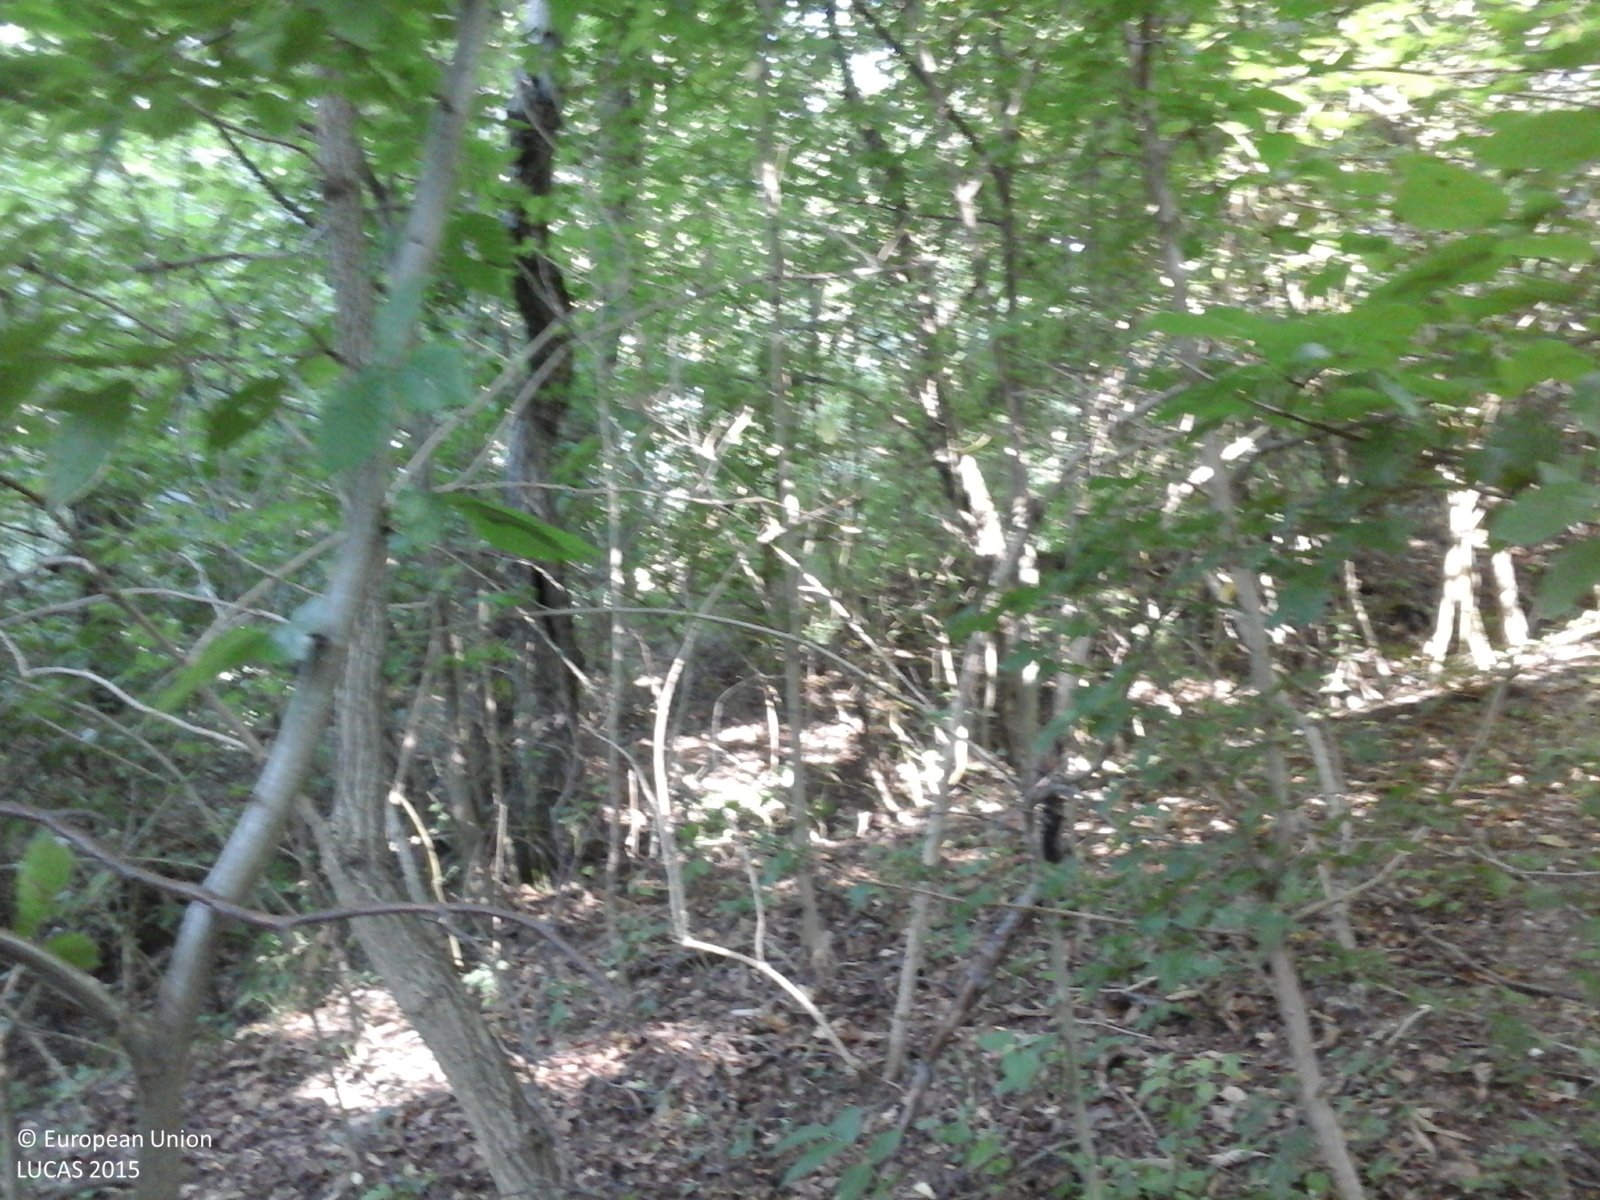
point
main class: Woodland
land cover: Broadleaved woodland
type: beech forest
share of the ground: > 75 %
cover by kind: broadleaved forest trees 100 %
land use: Forestry
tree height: > 5 m
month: July
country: RO
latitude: 45.0619
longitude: 24.7748
